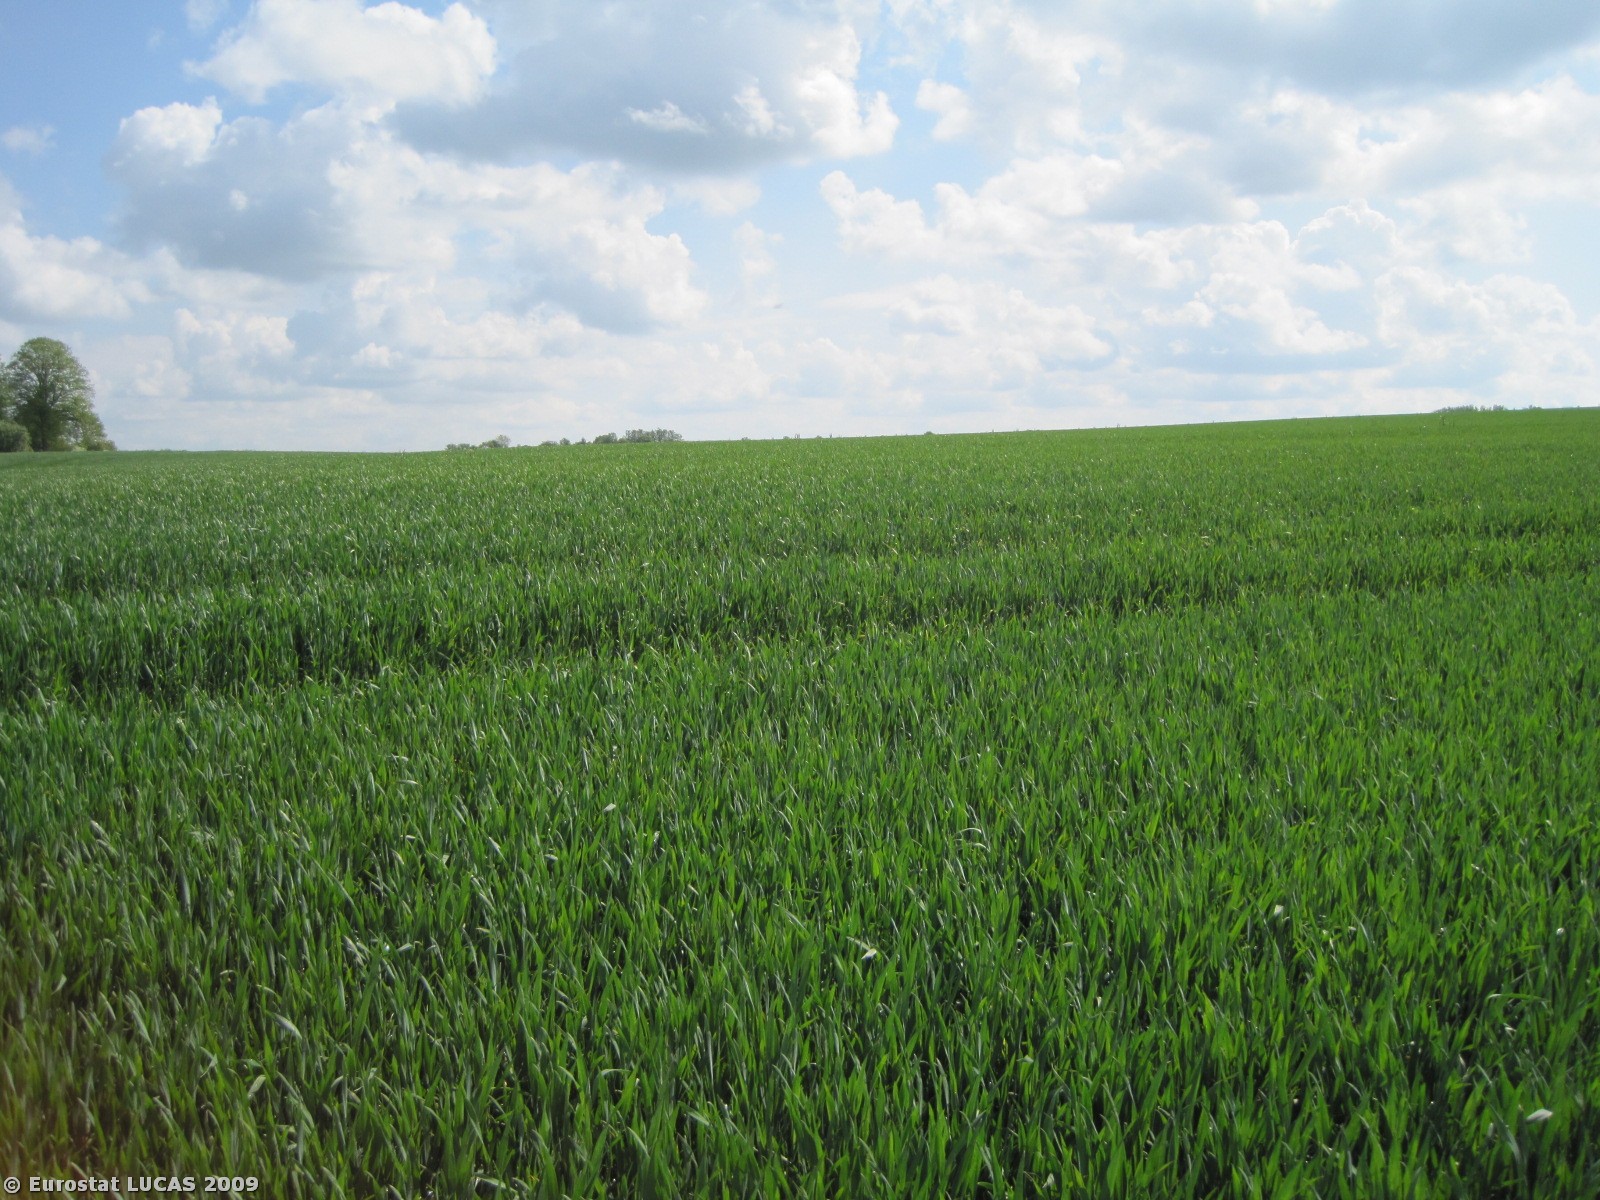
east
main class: Cropland
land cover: Common wheat
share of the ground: > 75 %
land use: Agriculture (excluding fallow land and kitchen gardens)
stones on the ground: < 10 %
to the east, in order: Common wheat
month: May
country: DK
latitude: 56.3133
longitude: 9.7255
